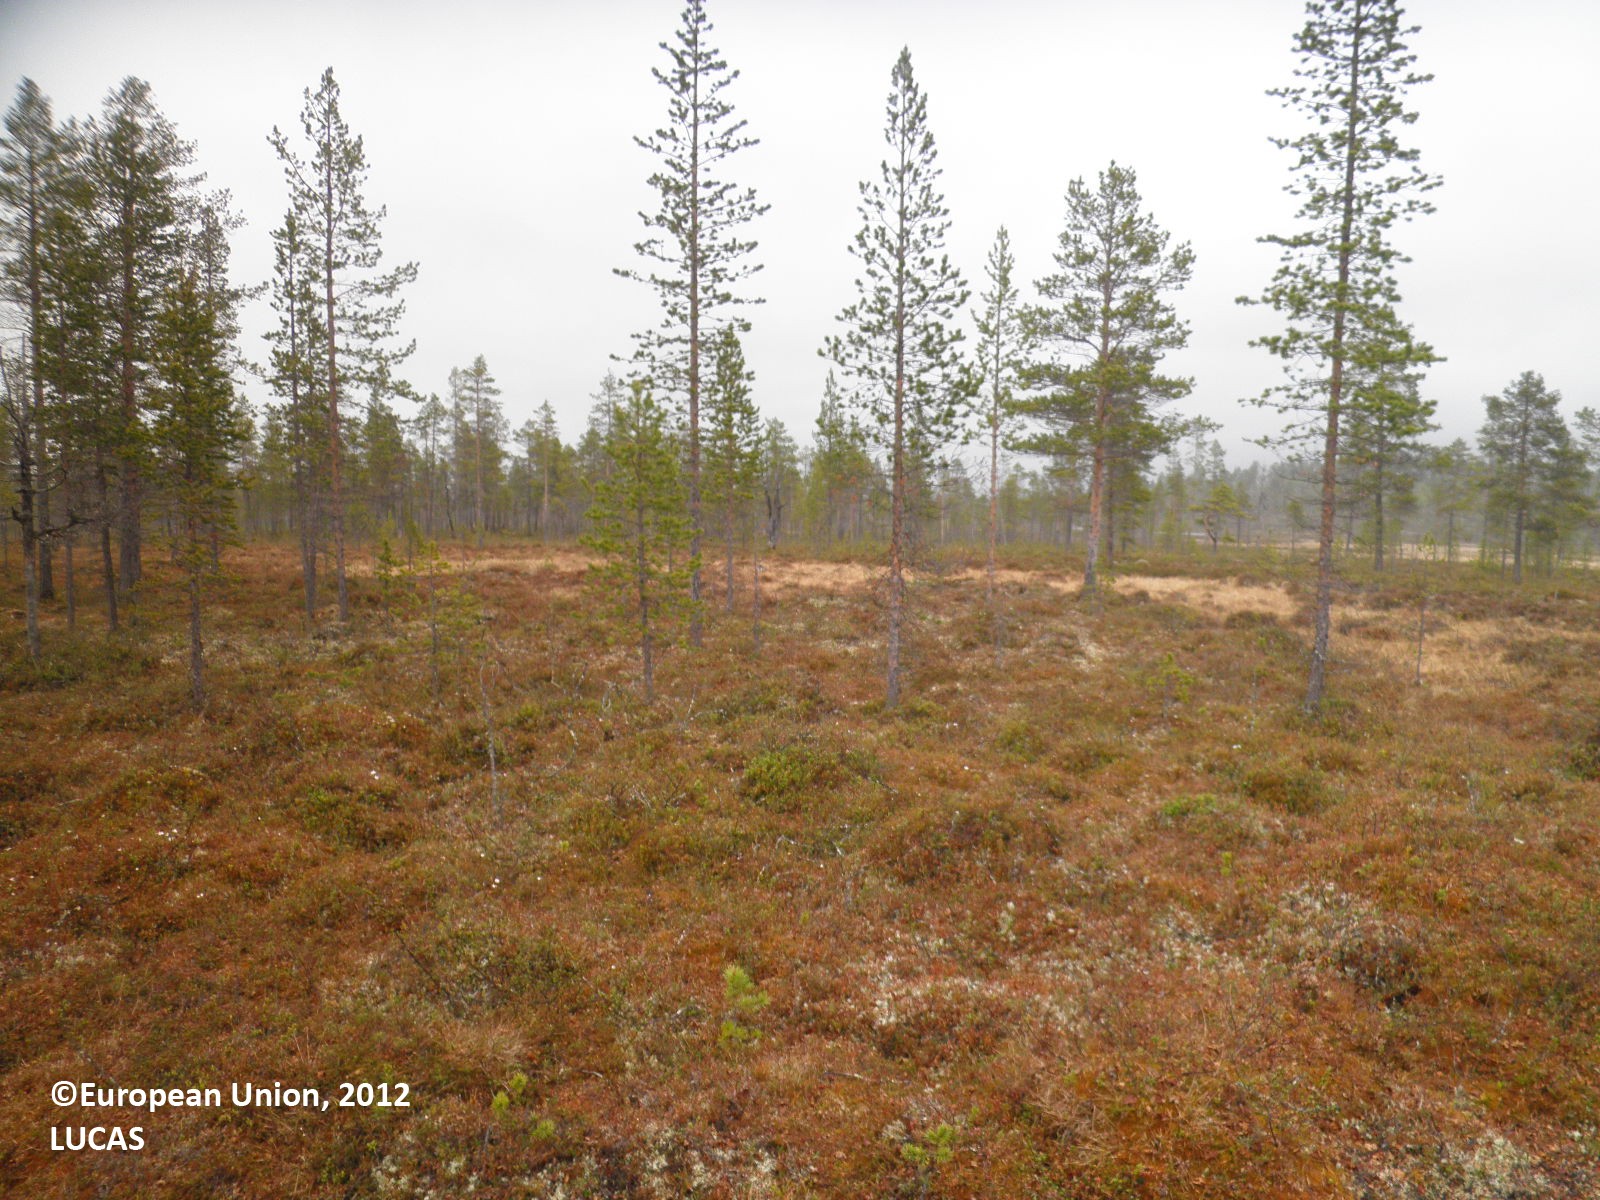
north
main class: Woodland
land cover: Pine dominated coniferous woodland
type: boreal forest
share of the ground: 25 - 50 %
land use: Forestry
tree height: > 5 m
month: June
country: FI
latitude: 68.9019
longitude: 26.5016
